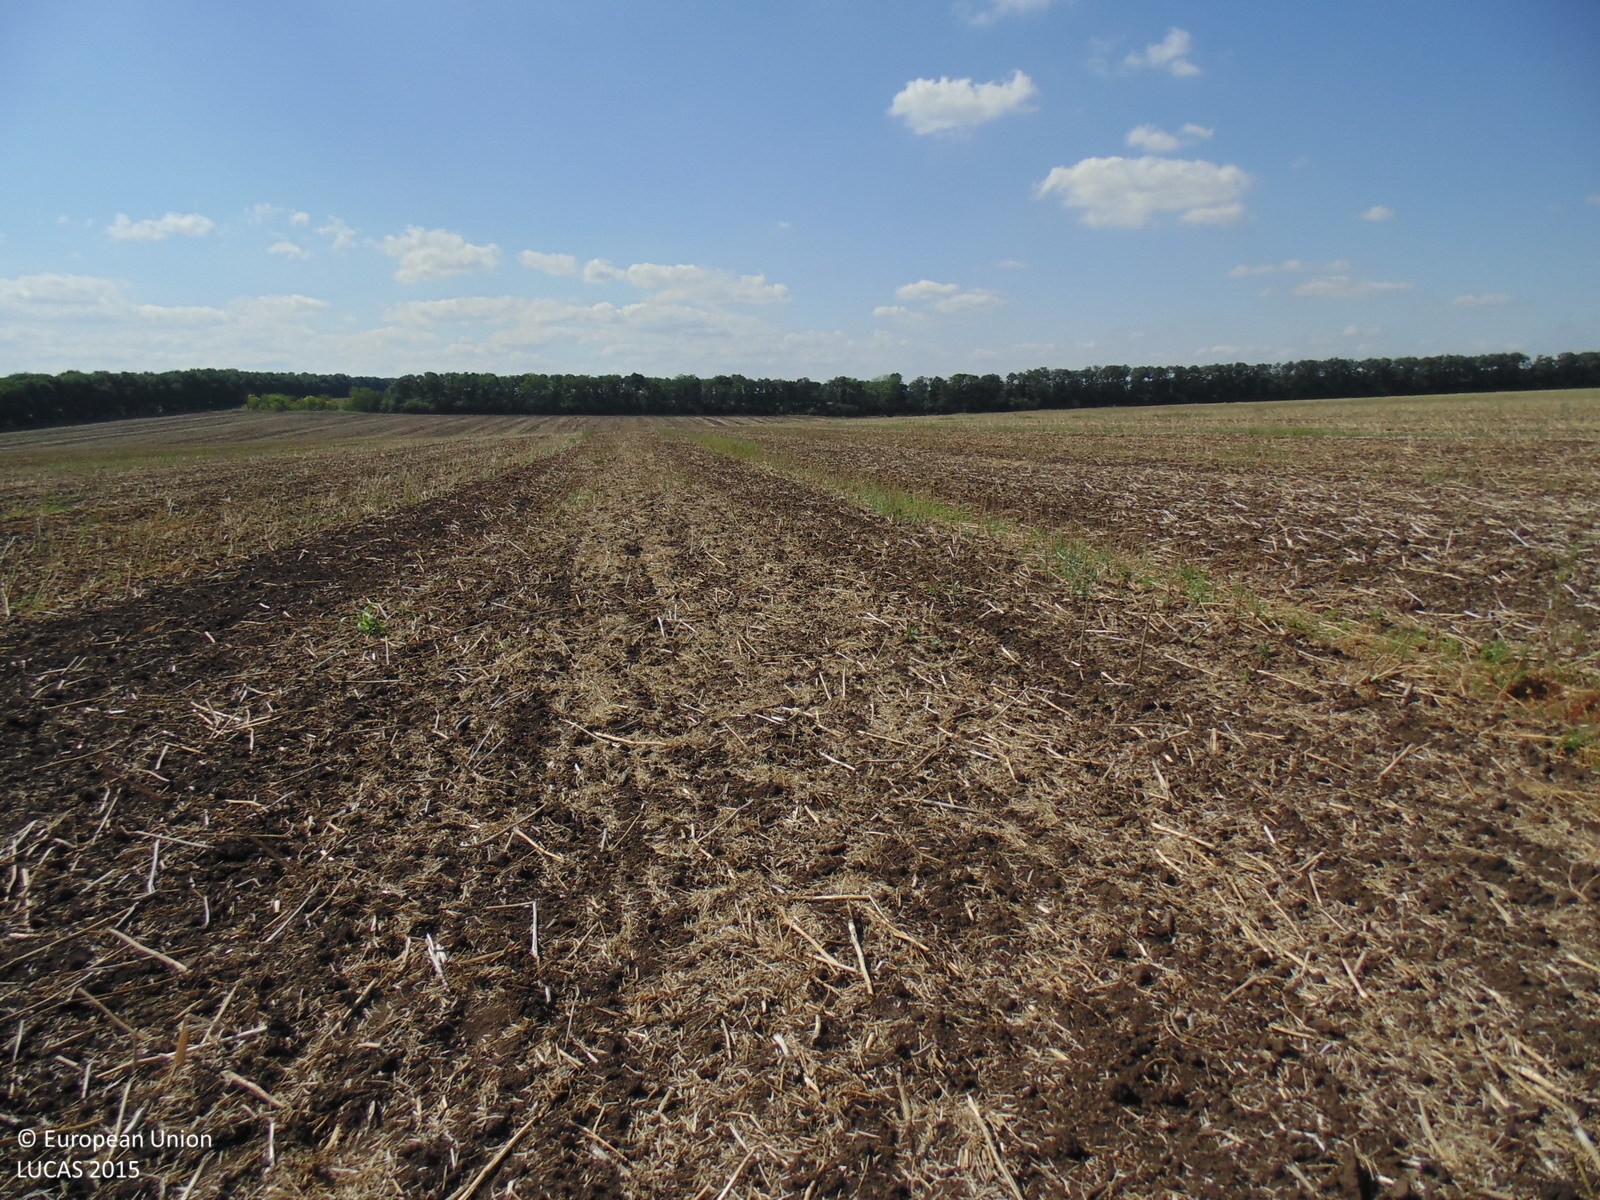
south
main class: Cropland
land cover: Rape and turnip rape
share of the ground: < 10 %
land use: Agriculture (excluding fallow land and kitchen gardens)
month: August
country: BG
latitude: 43.6789
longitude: 28.1253
